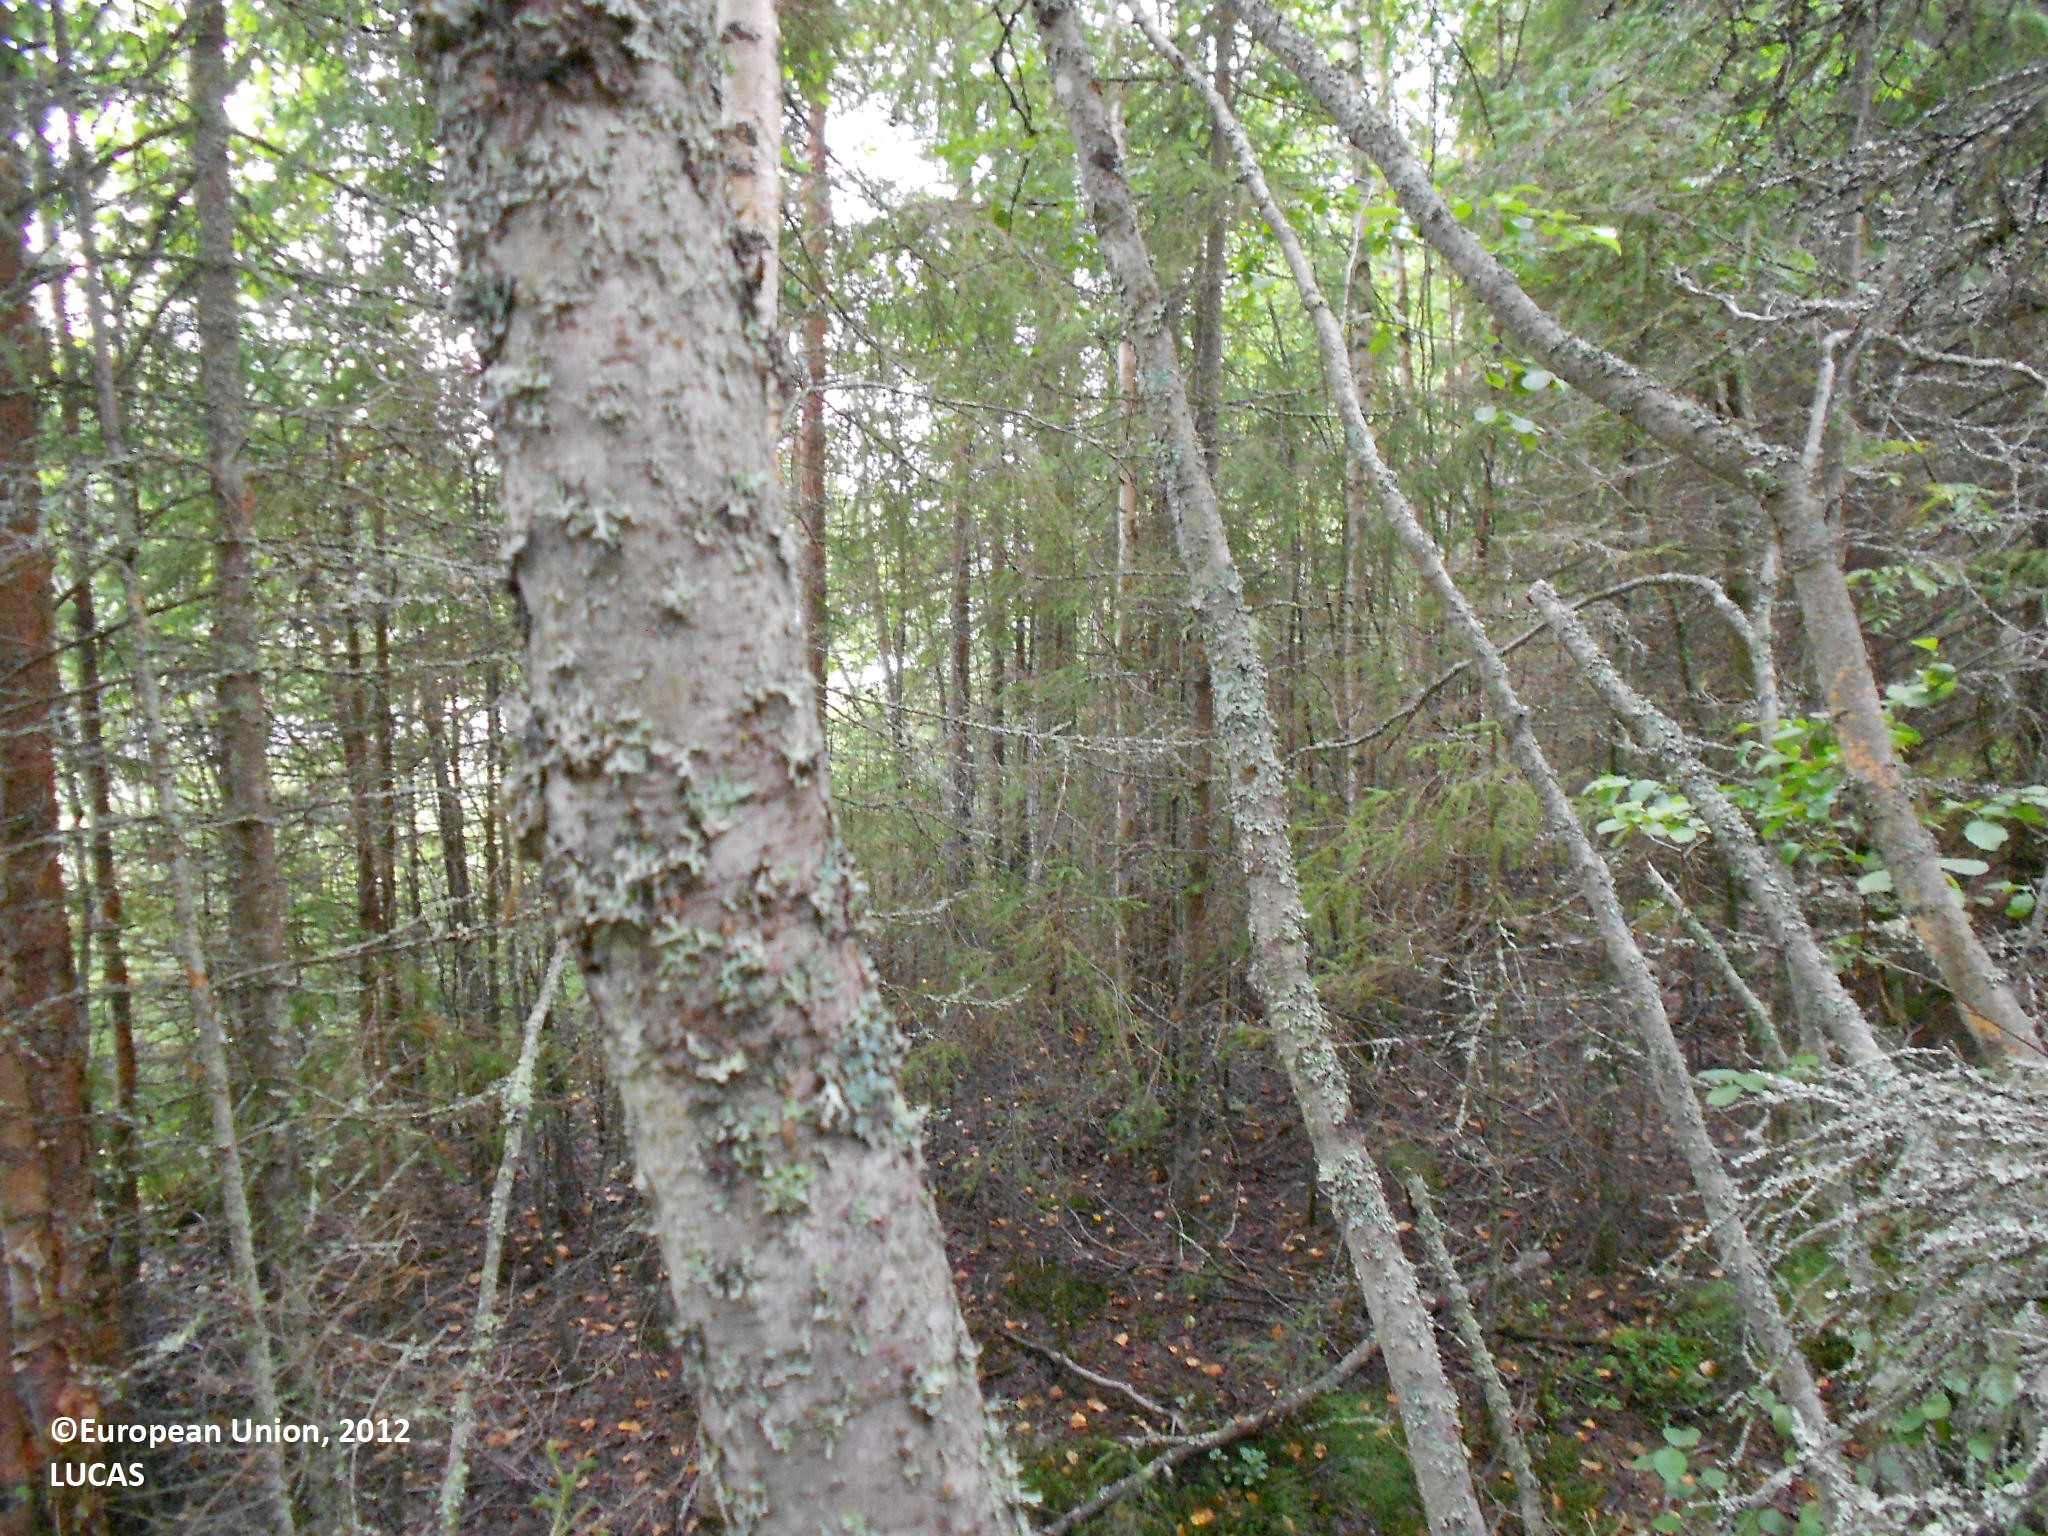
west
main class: Woodland
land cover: Spruce dominated coniferous woodland
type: boreal forest
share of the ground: > 75 %
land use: Forestry
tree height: > 5 m
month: August
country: FI
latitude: 63.5318
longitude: 28.8435
